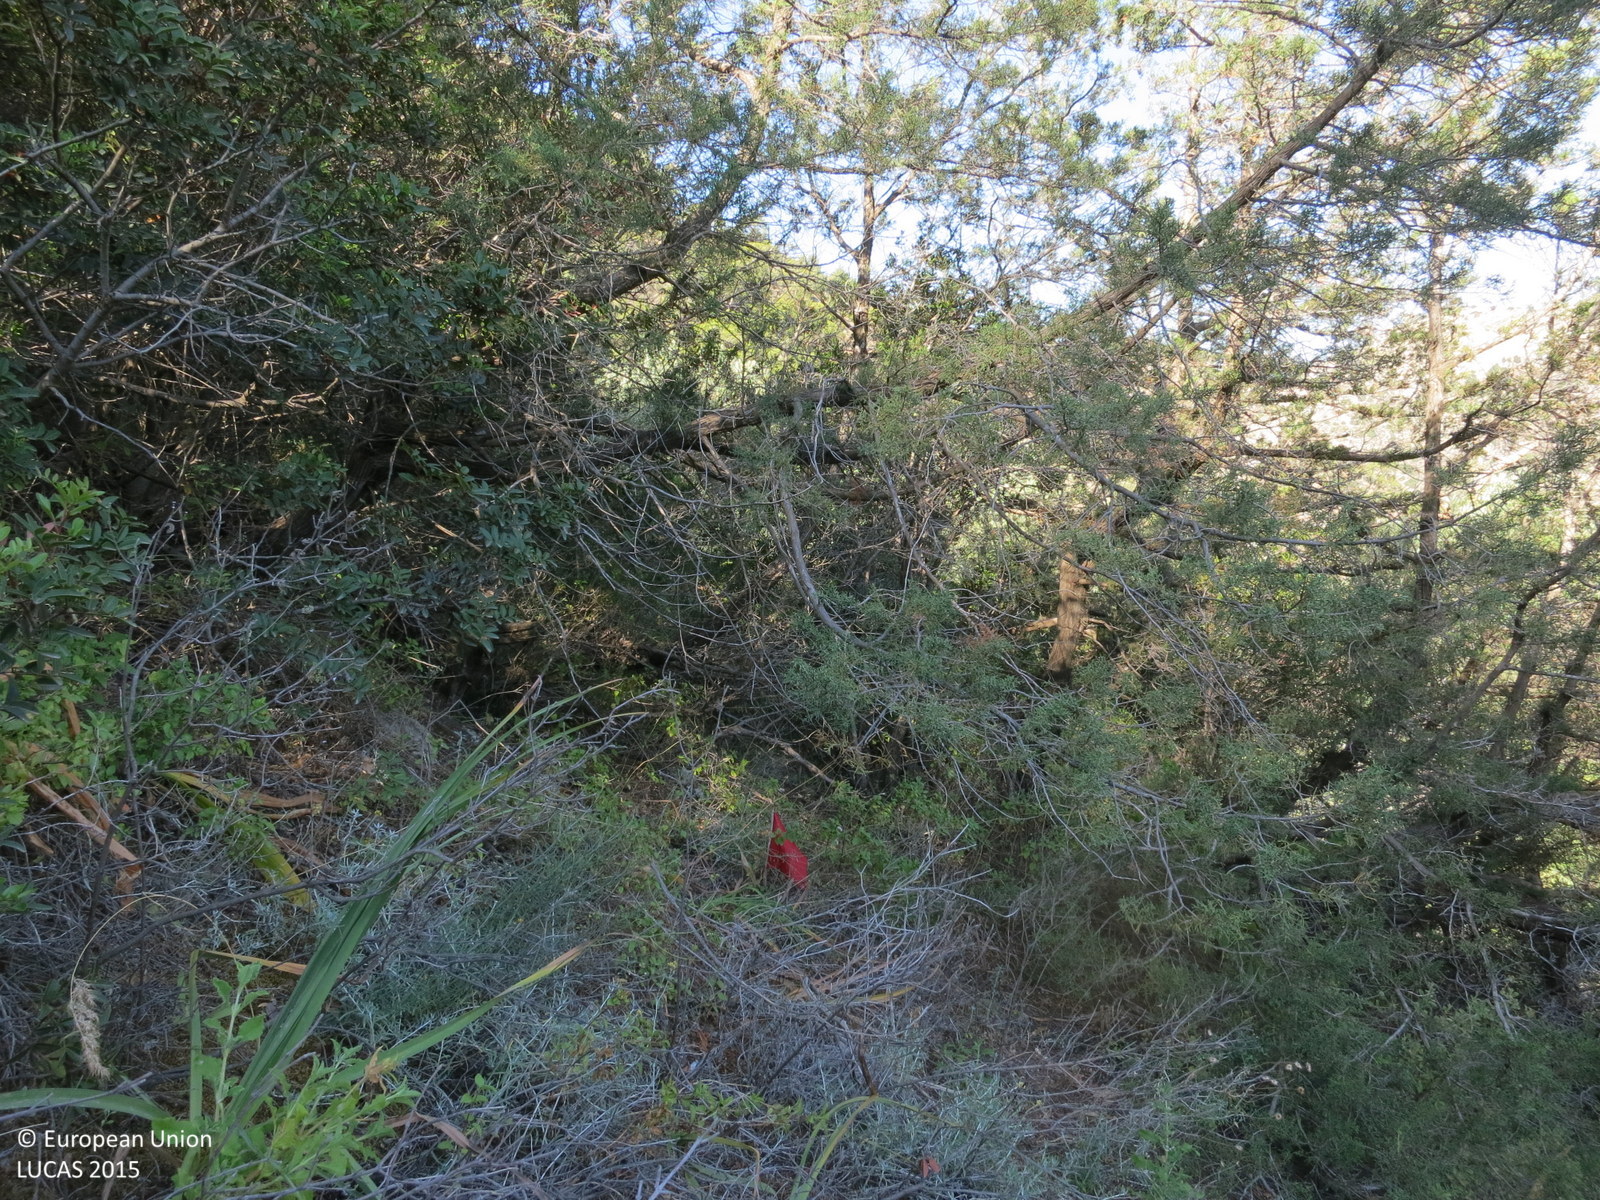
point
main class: Woodland
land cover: Pine dominated mixed woodland
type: coniferous forest of the mediterranean region
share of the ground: > 75 %
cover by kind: coniferous forest trees 50 %, broadleaved forest trees 25 %, shrubs 10 %, herbaceous plants 5 %
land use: Semi-natural and natural areas not in use
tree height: > 5 m
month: June
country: GR
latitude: 34.9940
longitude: 25.4929
